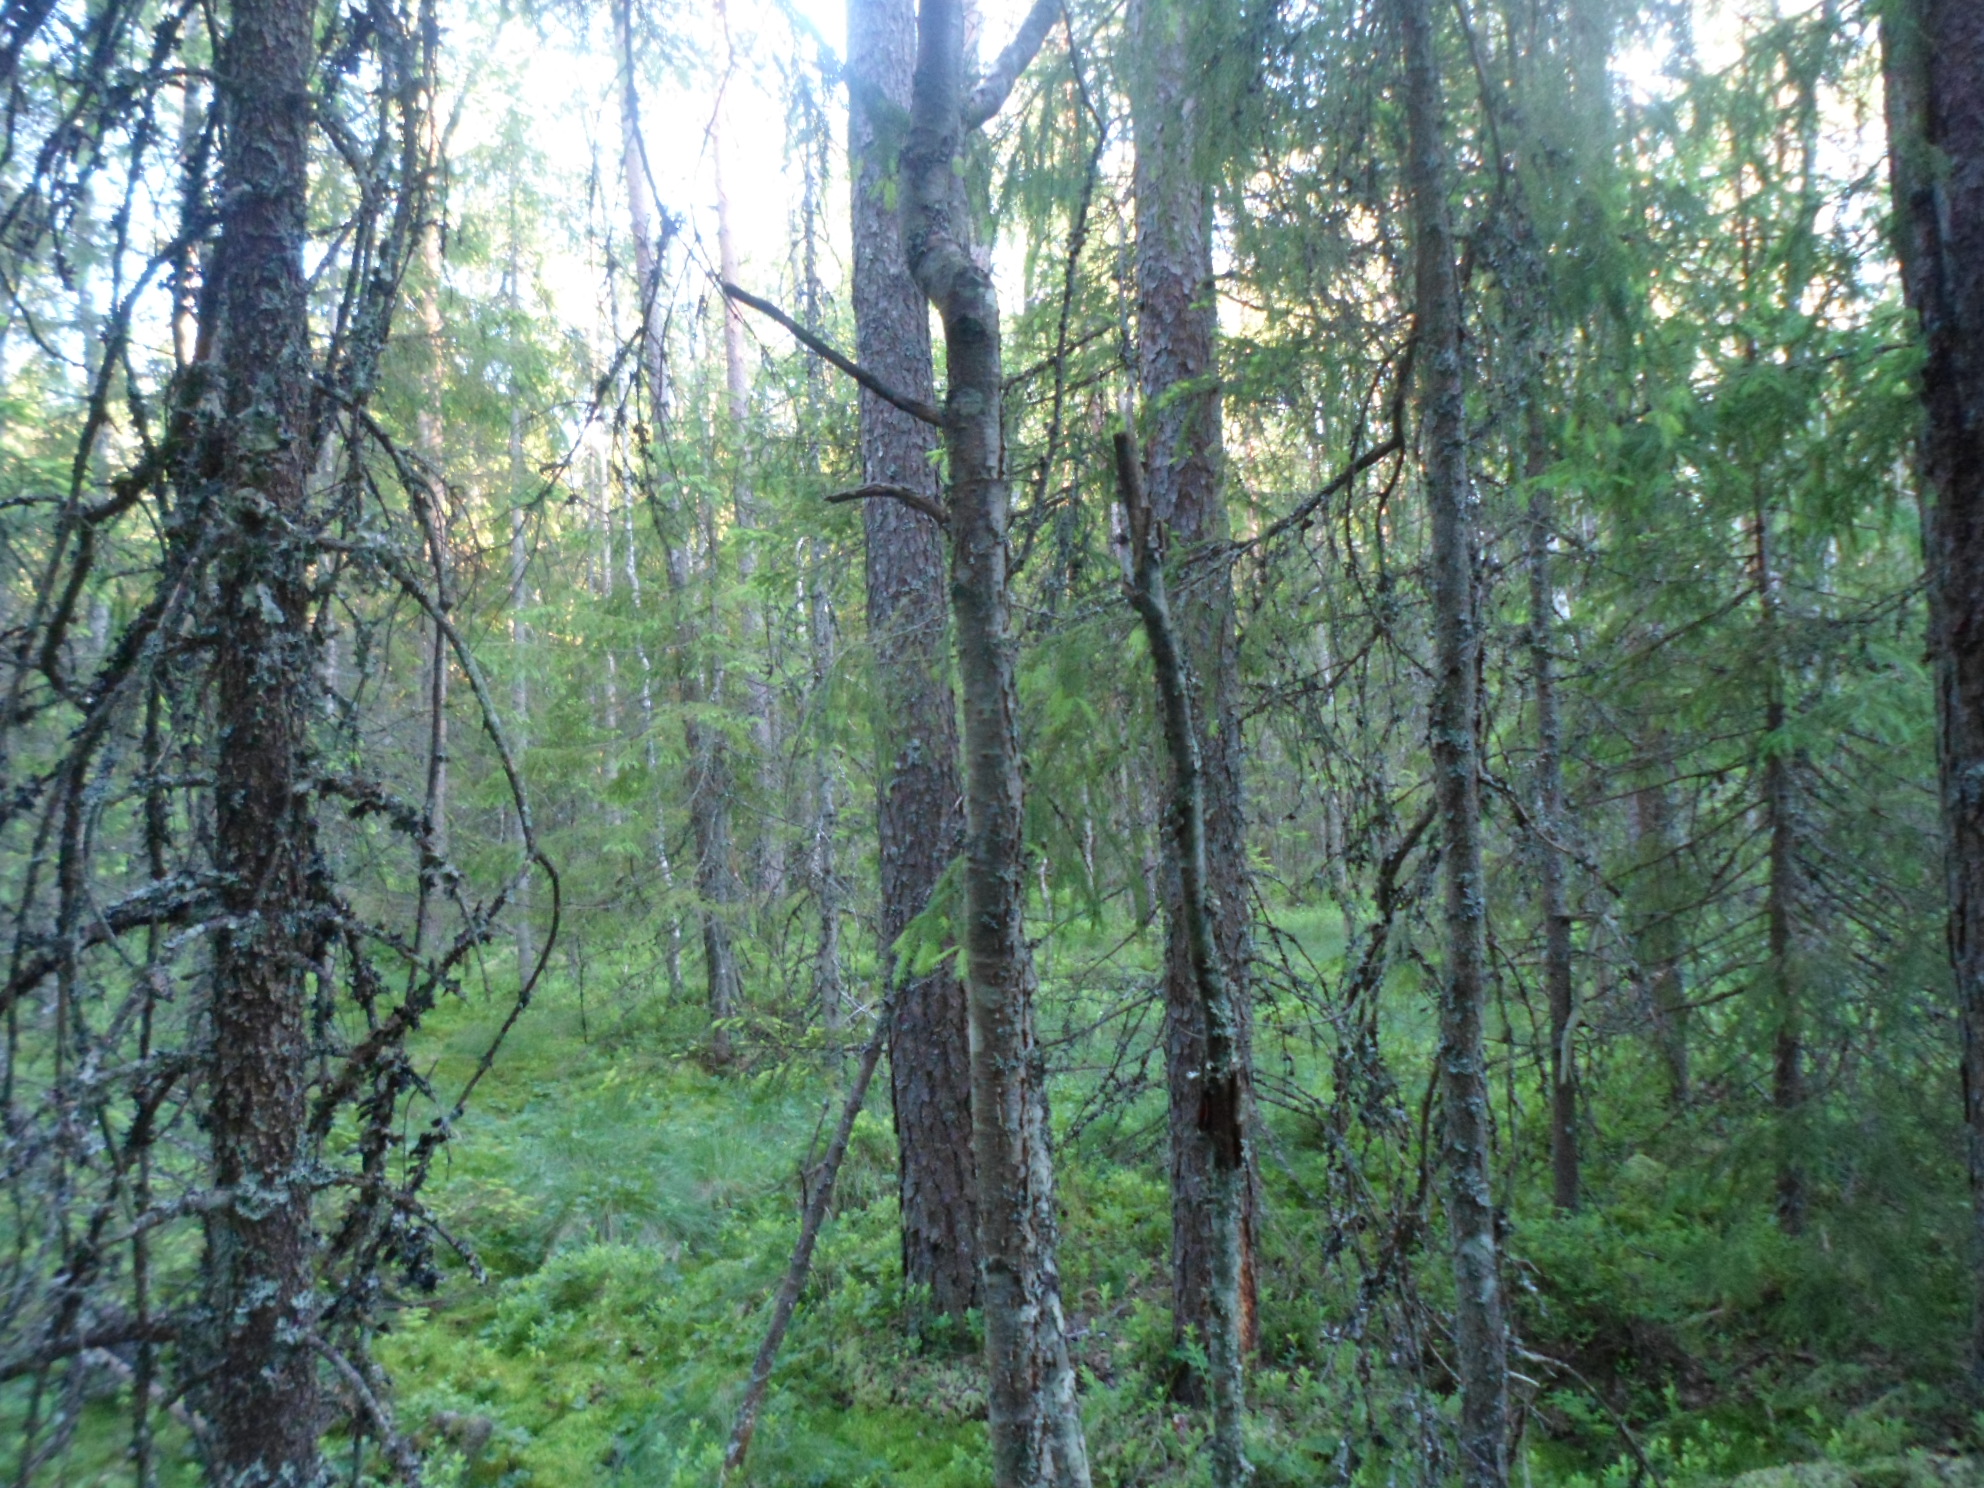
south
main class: Woodland
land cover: Pine dominated coniferous woodland
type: boreal forest
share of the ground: 50 - 75 %
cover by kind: coniferous forest trees 50 %, lichens and mosses 25 %, broadleaved forest trees 10 %, shrubs 10 %, herbaceous plants 5 %
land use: Forestry
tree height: > 5 m
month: July
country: SE
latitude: 57.5164
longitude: 14.4197
